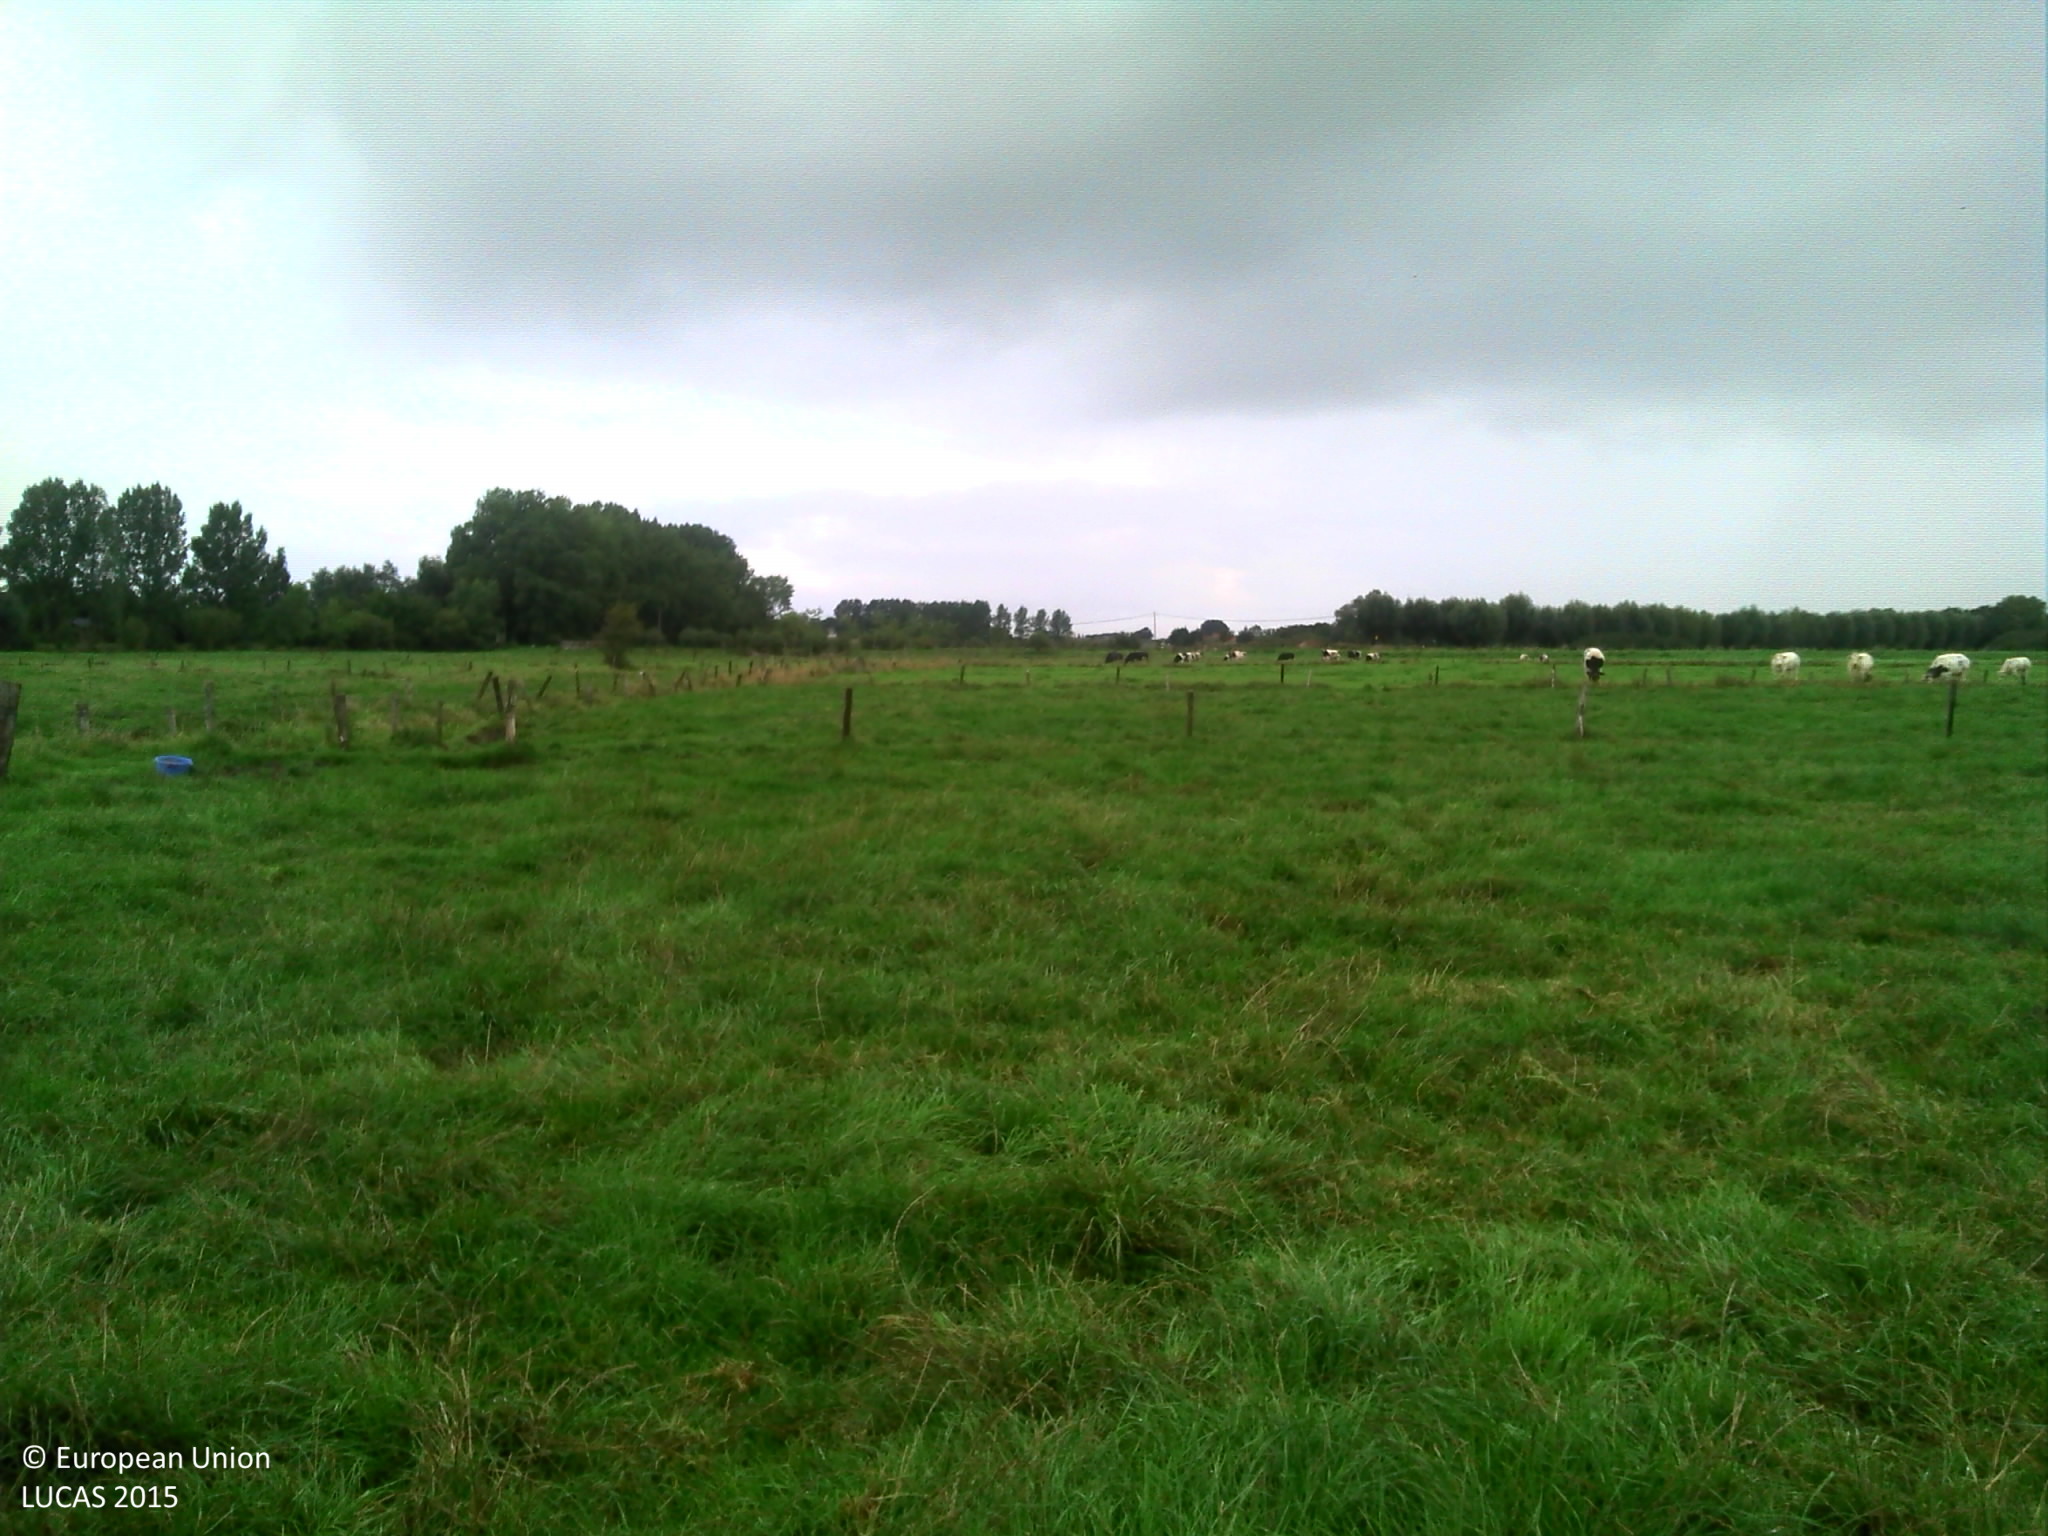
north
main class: Grassland
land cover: Grassland without tree/shrub cover
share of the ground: > 75 %
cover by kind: herbaceous plants 100 %
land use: Agriculture (excluding fallow land and kitchen gardens)
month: September
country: BE
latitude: 50.9441
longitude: 2.7156
